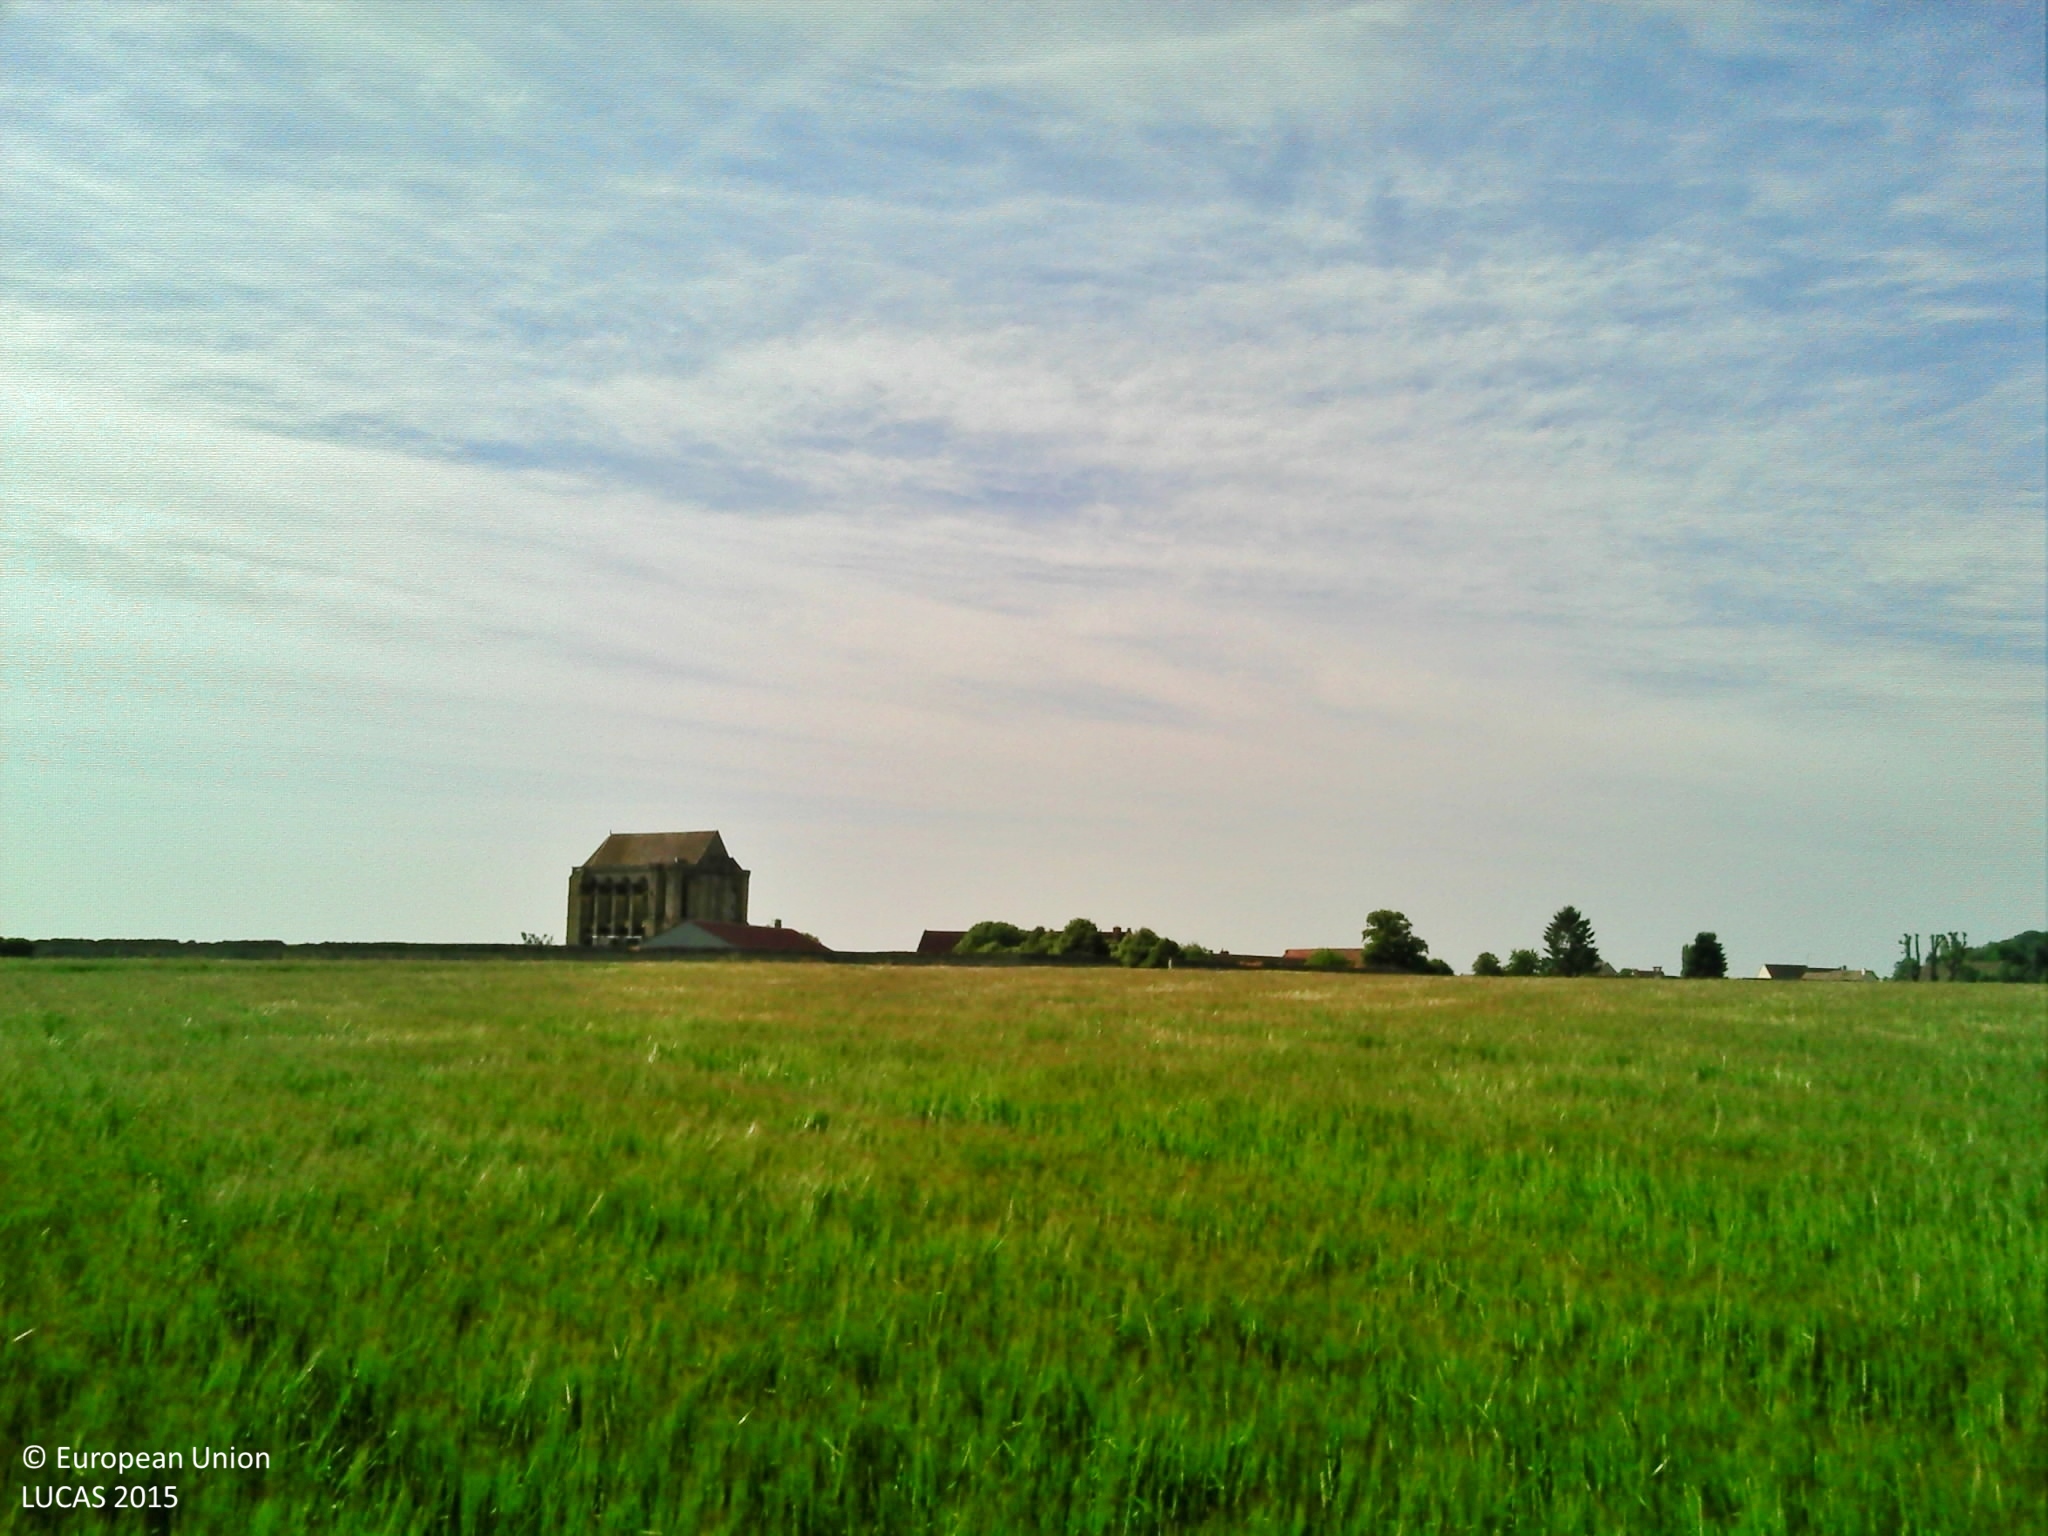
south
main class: Cropland
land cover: Barley
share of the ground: > 75 %
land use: Agriculture (excluding fallow land and kitchen gardens)
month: June
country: FR
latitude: 49.5262
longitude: 2.5695
